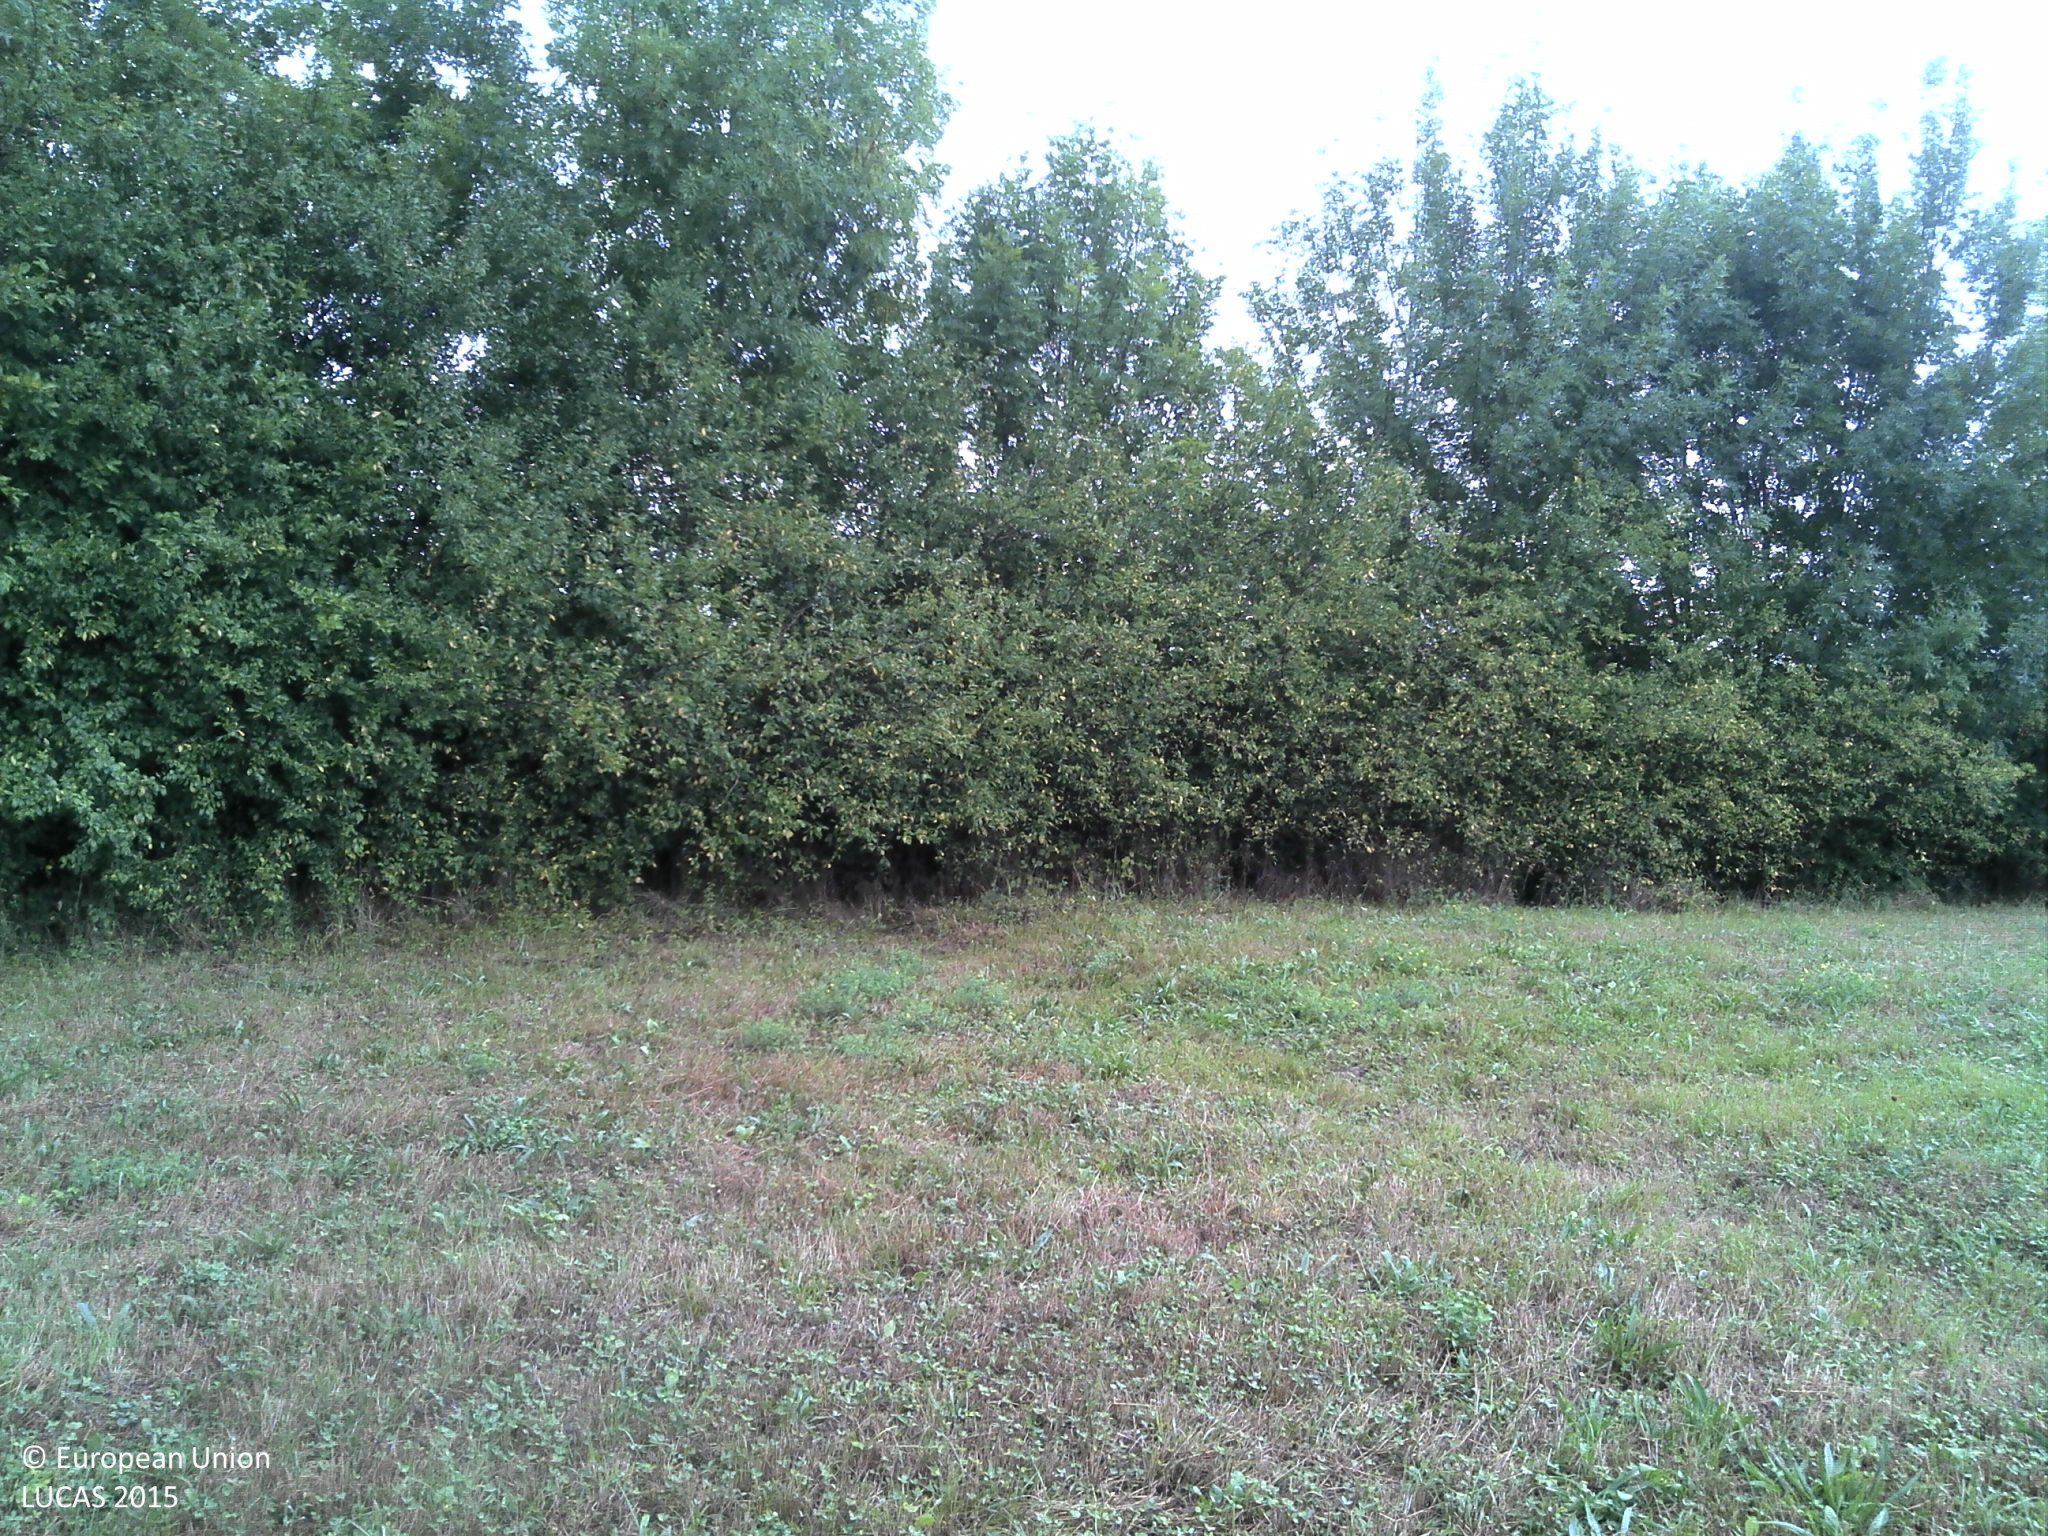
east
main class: Cropland
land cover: Clovers
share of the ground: > 75 %
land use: Agriculture (excluding fallow land and kitchen gardens)
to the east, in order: Clovers; Shrubland with sparse tree cover; Lucerne; Spontaneously vegetated surfaces; Tracks; Spontaneously vegetated surfaces; Lucerne; Tracks; Grass margins; Maize; Spontaneously vegetated surfaces; Grass margins; Ditches and canals; Grass margins
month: August
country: HR
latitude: 45.4788
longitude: 15.6636
